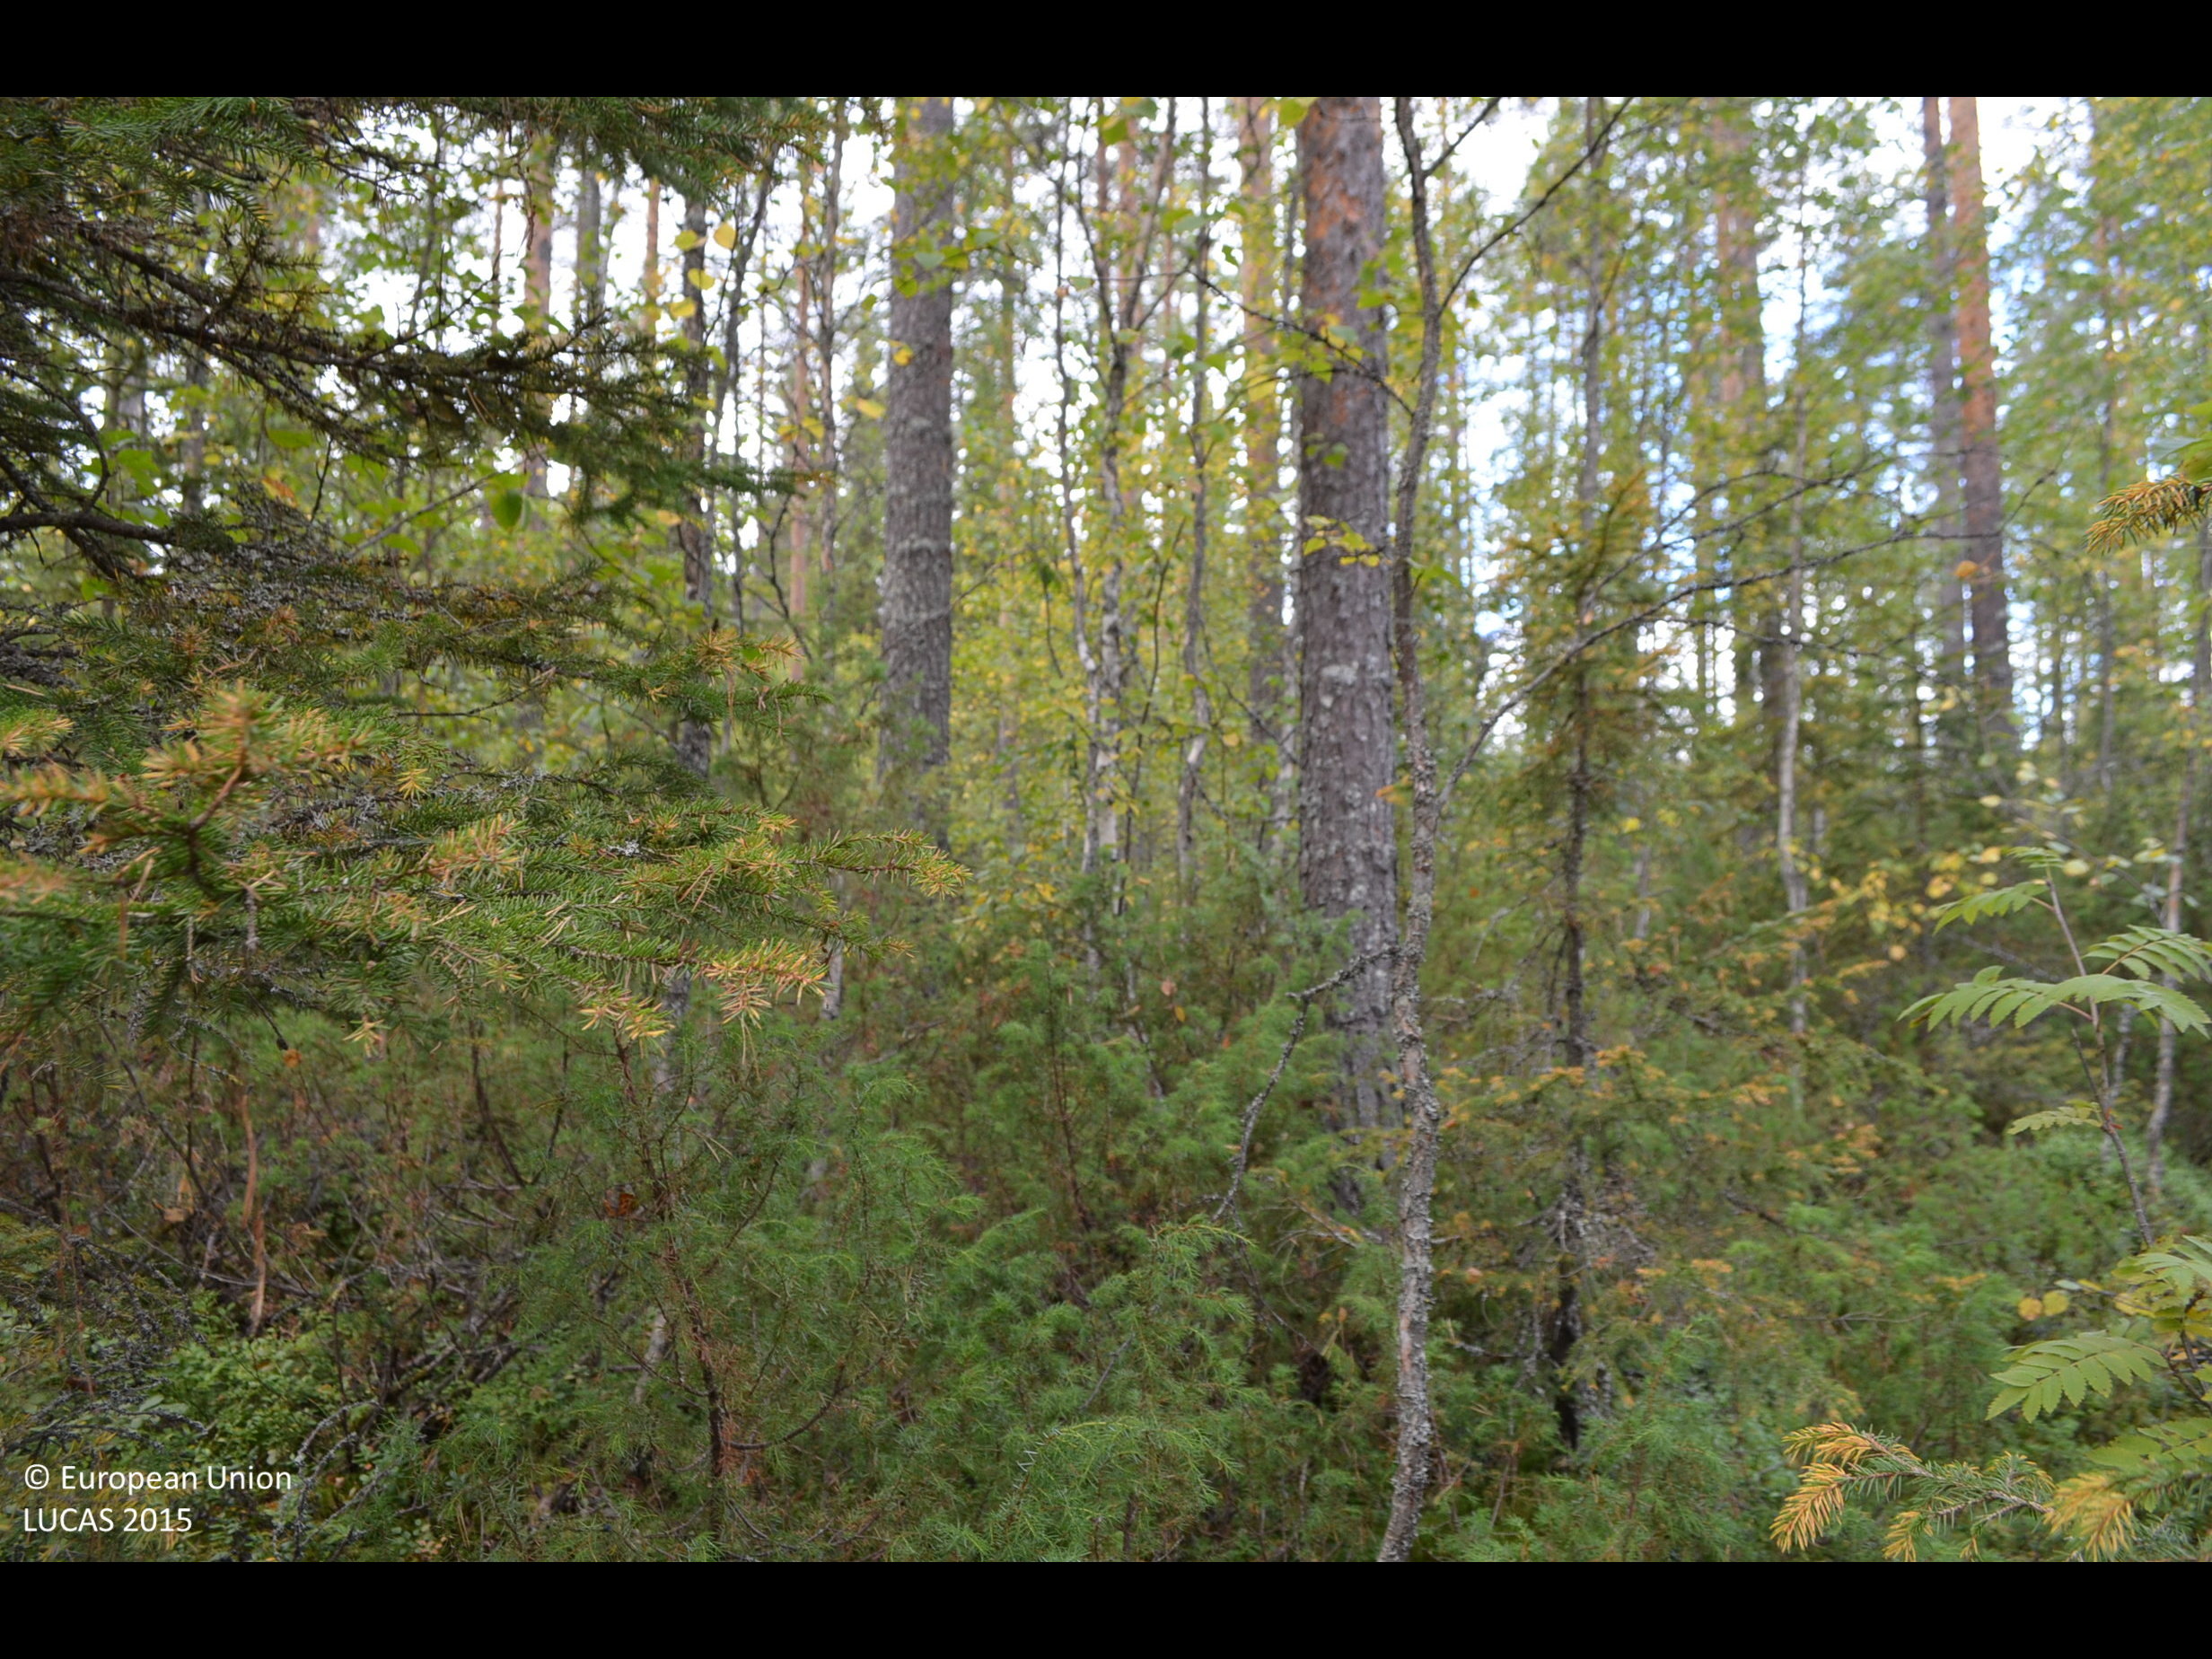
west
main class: Woodland
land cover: Pine dominated mixed woodland
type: boreal forest
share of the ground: > 75 %
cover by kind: coniferous forest trees 55 %, broadleaved forest trees 20 %, shrubs 20 %, lichens and mosses 5 %
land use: Forestry
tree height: > 5 m
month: September
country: FI
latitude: 62.6694
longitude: 24.3966
